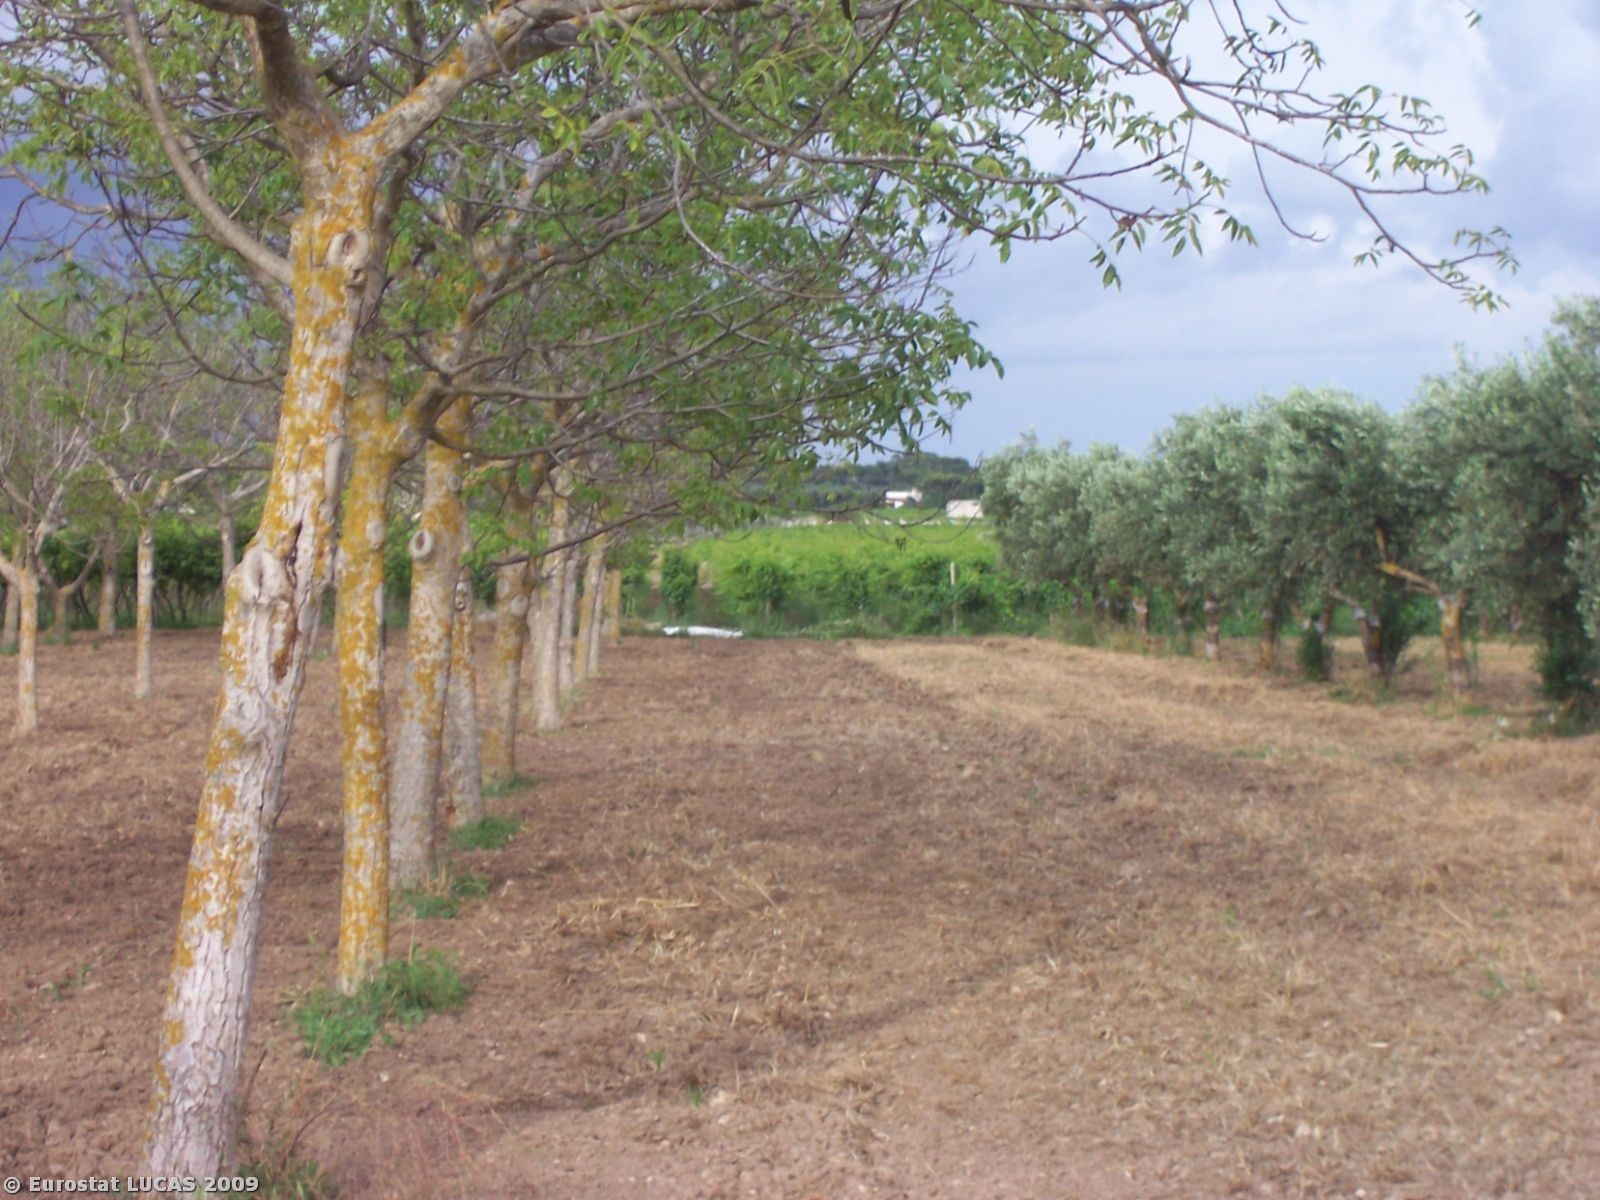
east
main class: Cropland
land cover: Nuts trees
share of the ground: 50 - 75 %
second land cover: Bare land
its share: > 75 %
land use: Agriculture (excluding fallow land and kitchen gardens)
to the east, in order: Nuts trees; Bare land; Vineyards; Bare land; Grass margins; Paved roads, cycling and walking lanes; Grass margins; Vineyards; Bare land
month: June
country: IT
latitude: 40.4335
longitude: 17.5080
